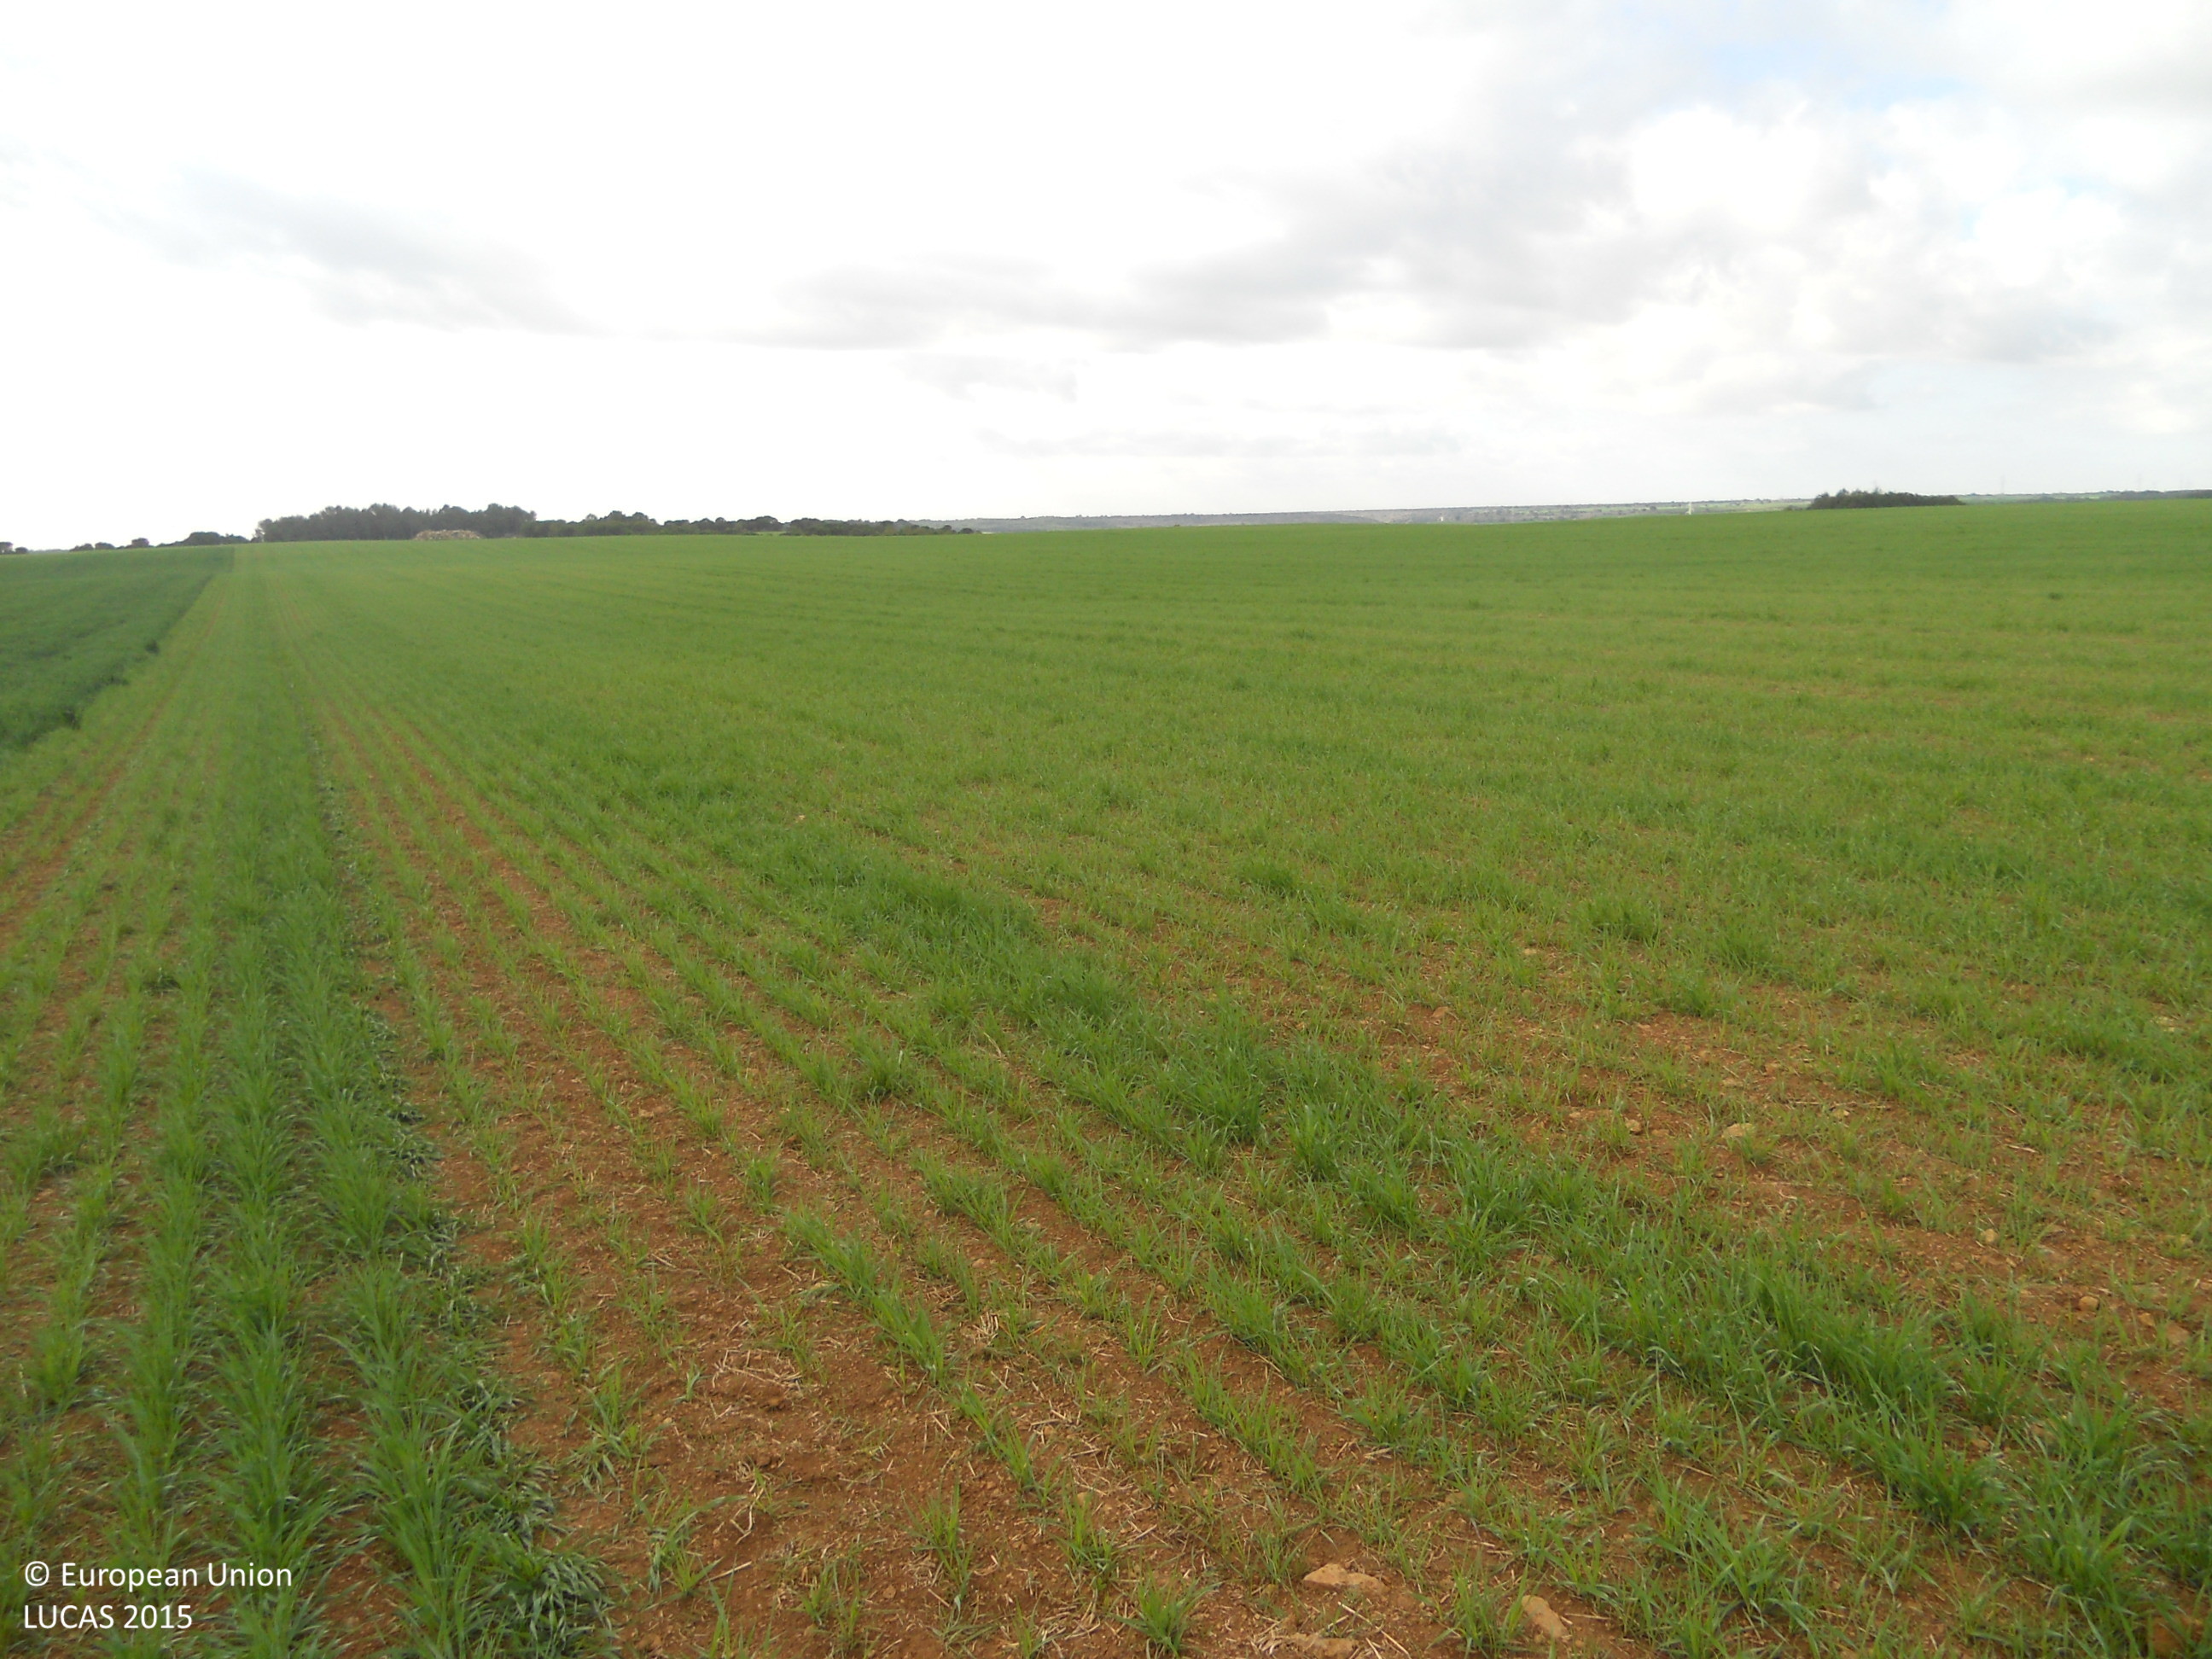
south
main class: Cropland
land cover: Barley
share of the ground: > 75 %
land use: Agriculture (excluding fallow land and kitchen gardens)
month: April
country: ES
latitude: 42.1767
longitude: -4.3423
